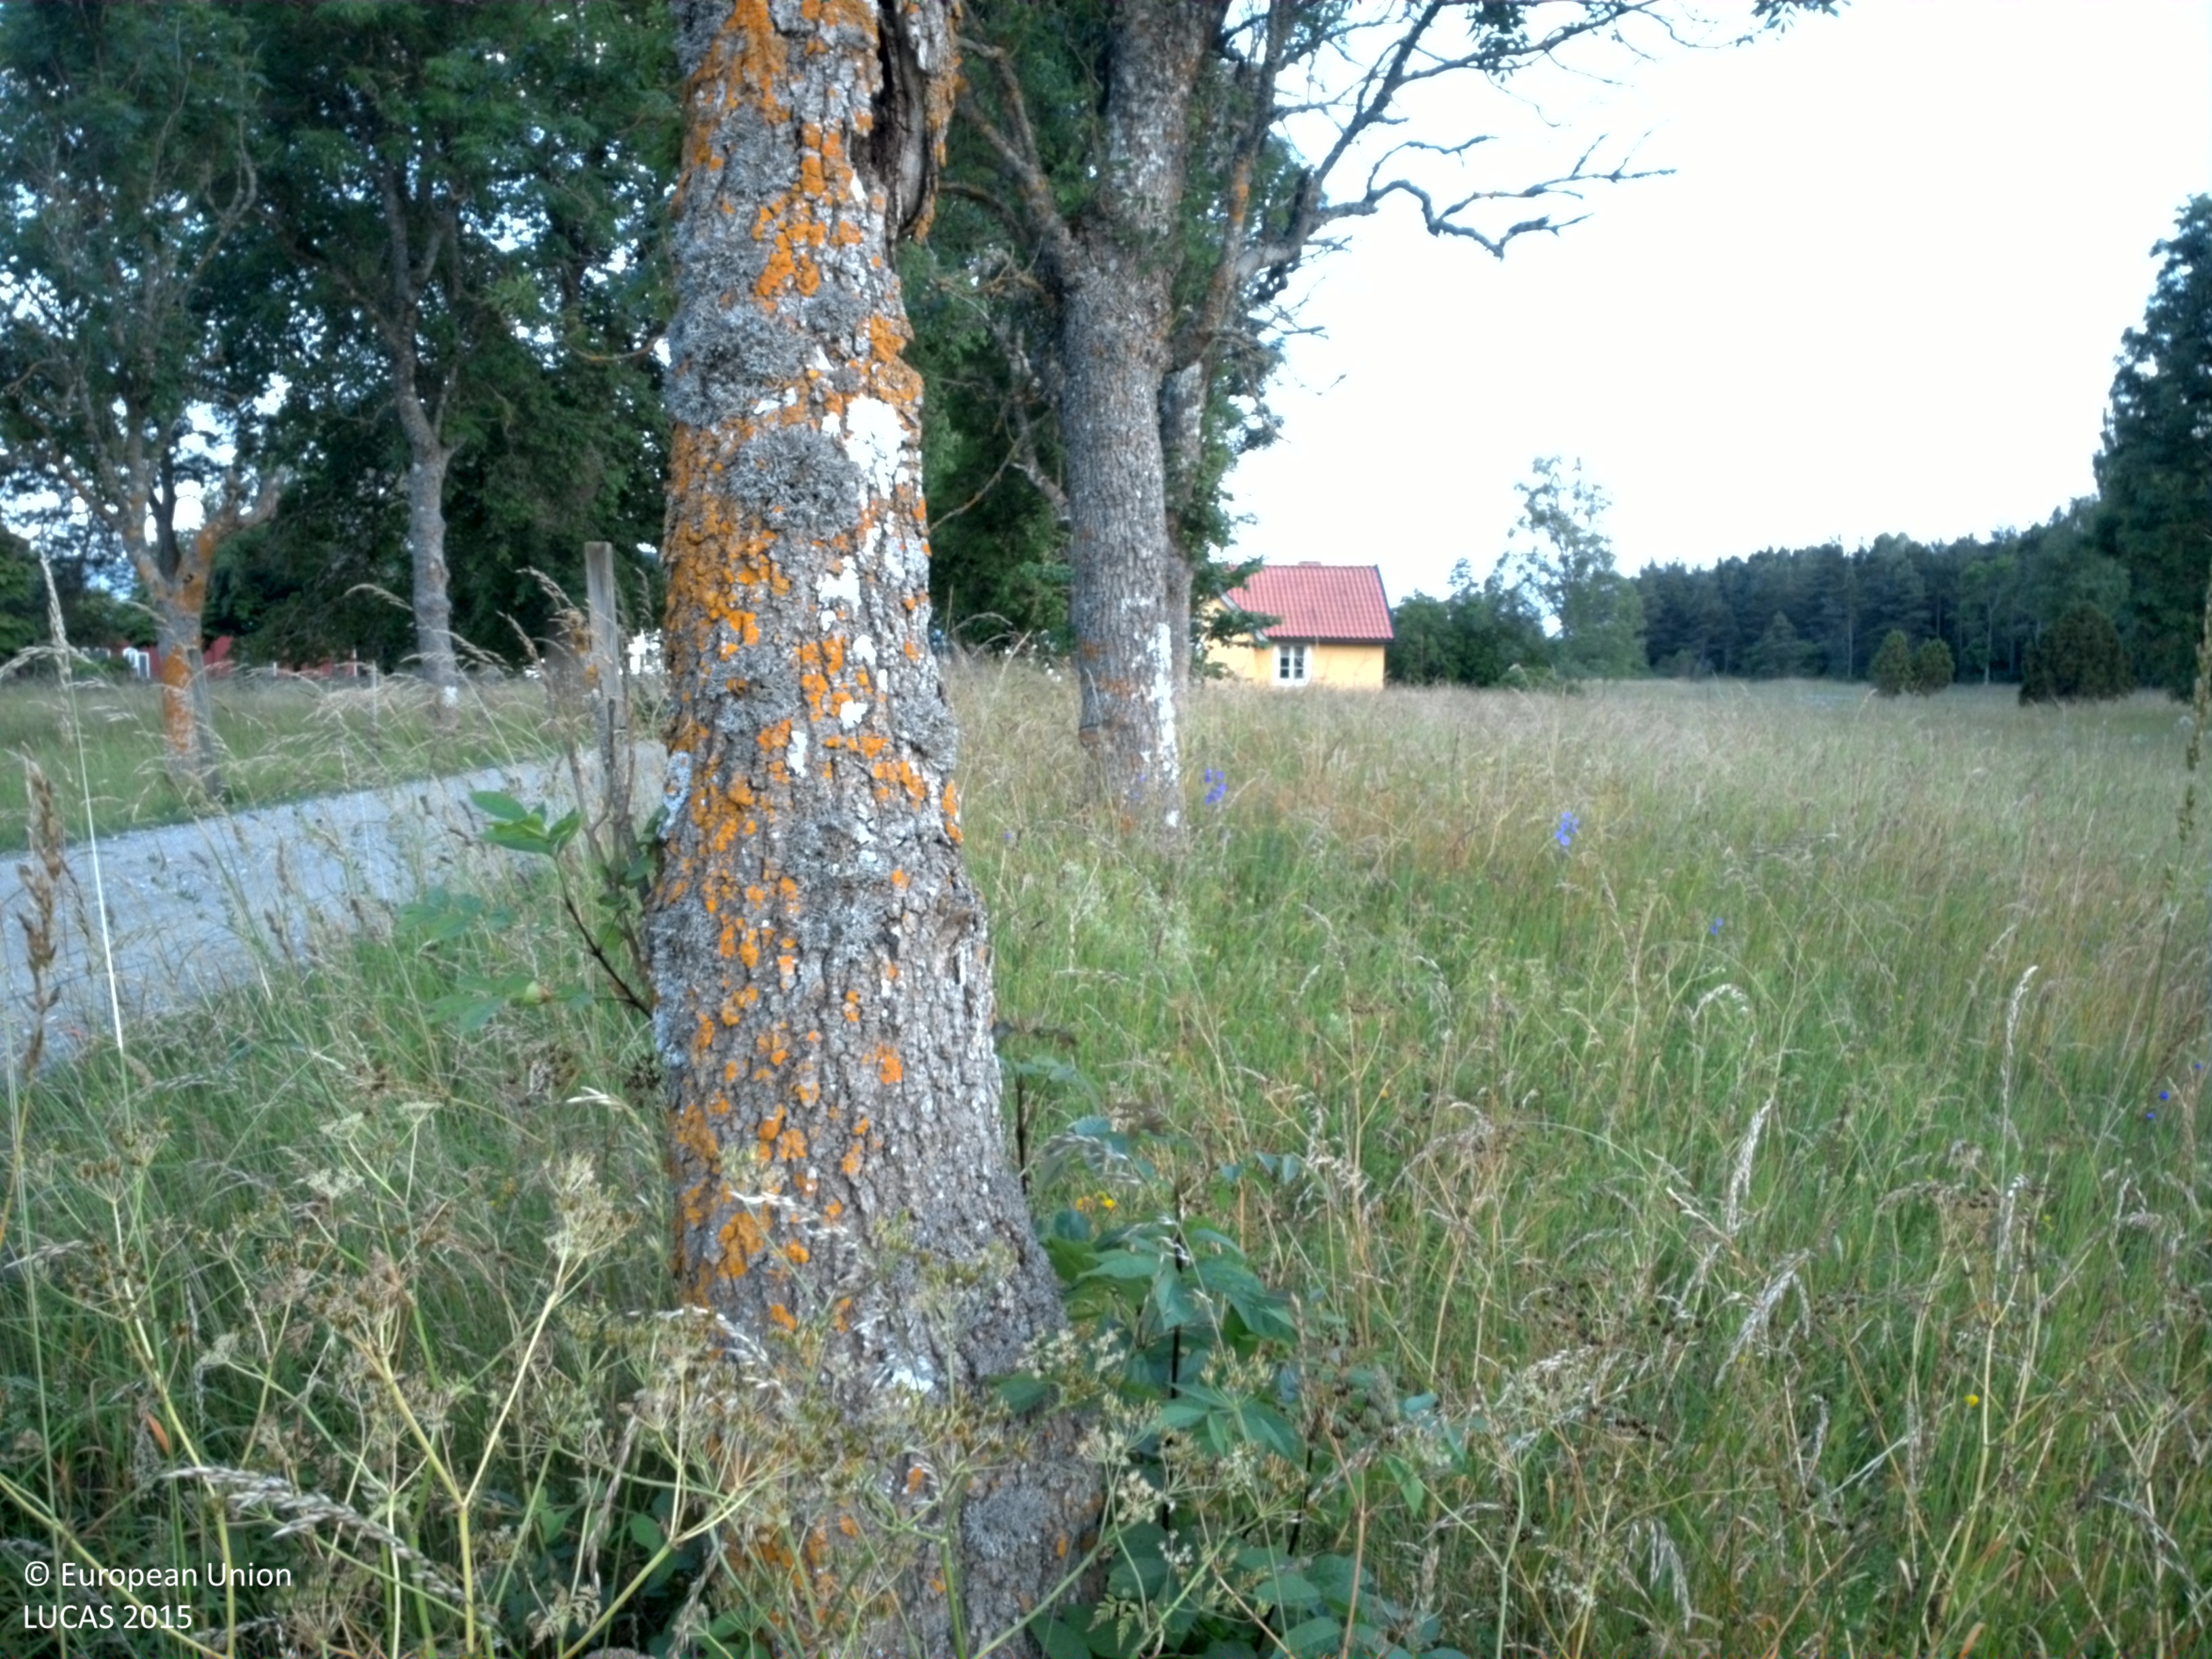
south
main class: Grassland
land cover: Grassland with sparse tree/shrub cover
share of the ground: > 75 %
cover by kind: herbaceous plants 95 %, broadleaved forest trees 5 %
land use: Agriculture (excluding fallow land and kitchen gardens)
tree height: > 5 m
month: July
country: SE
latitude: 57.6471
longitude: 18.7052
